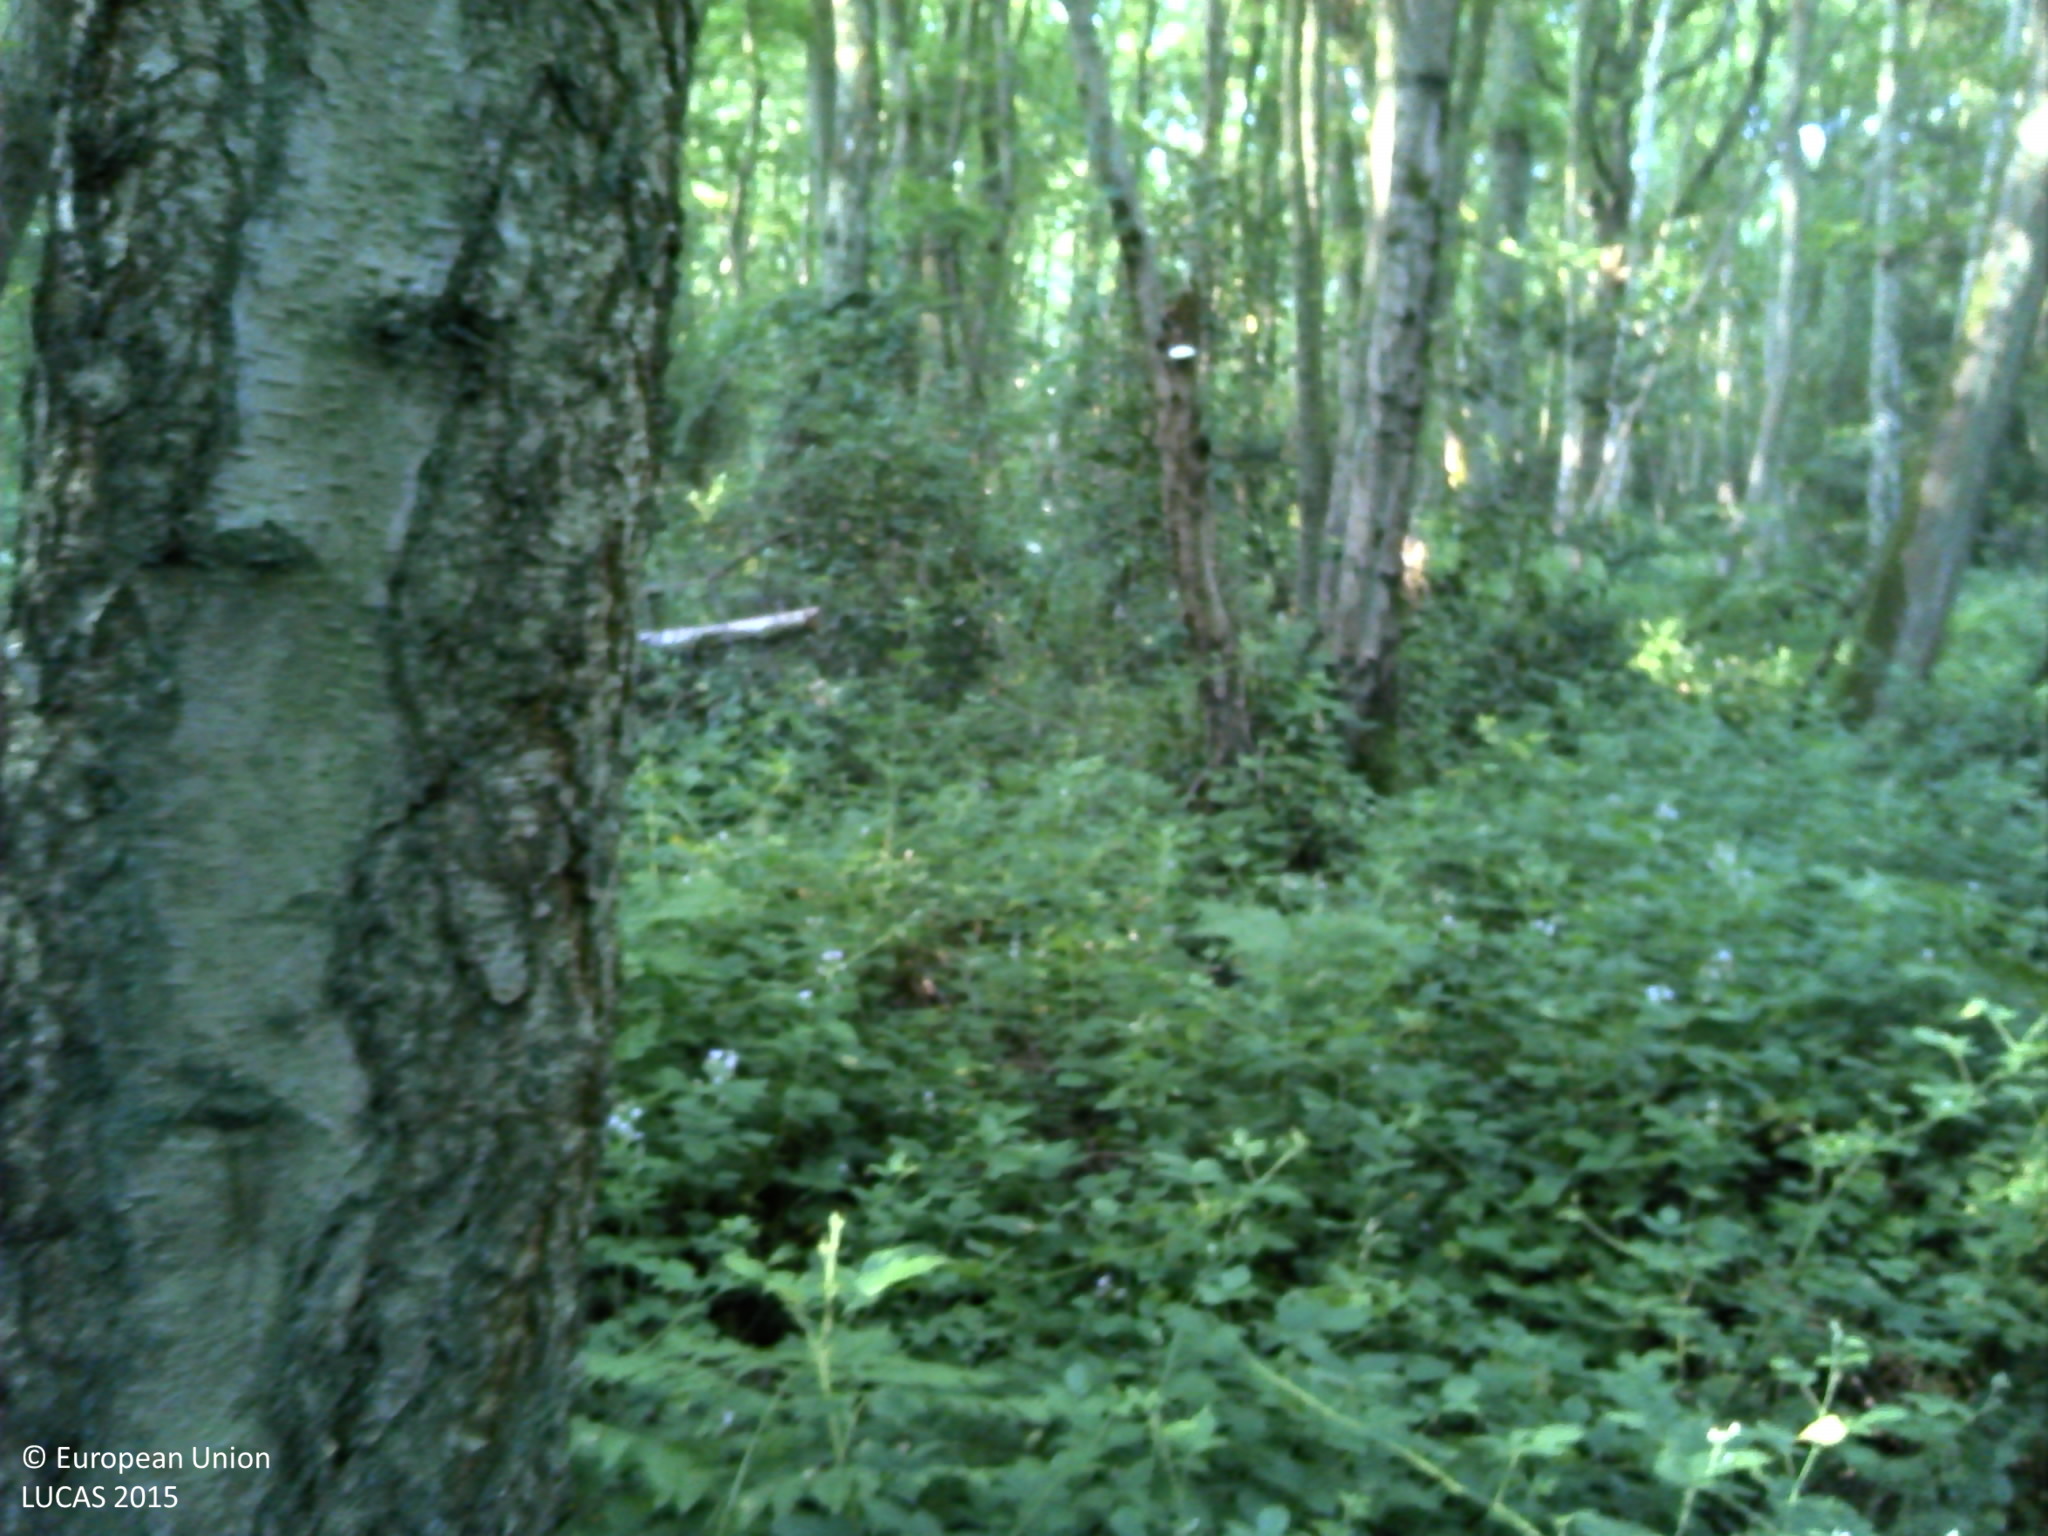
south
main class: Woodland
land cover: Broadleaved woodland
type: acidophilous oak and oak-birch forest
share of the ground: > 75 %
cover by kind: broadleaved forest trees 100 %
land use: Forestry
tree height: > 5 m
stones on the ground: 25 - 50 %
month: July
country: FR
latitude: 49.3579
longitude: 1.2370
